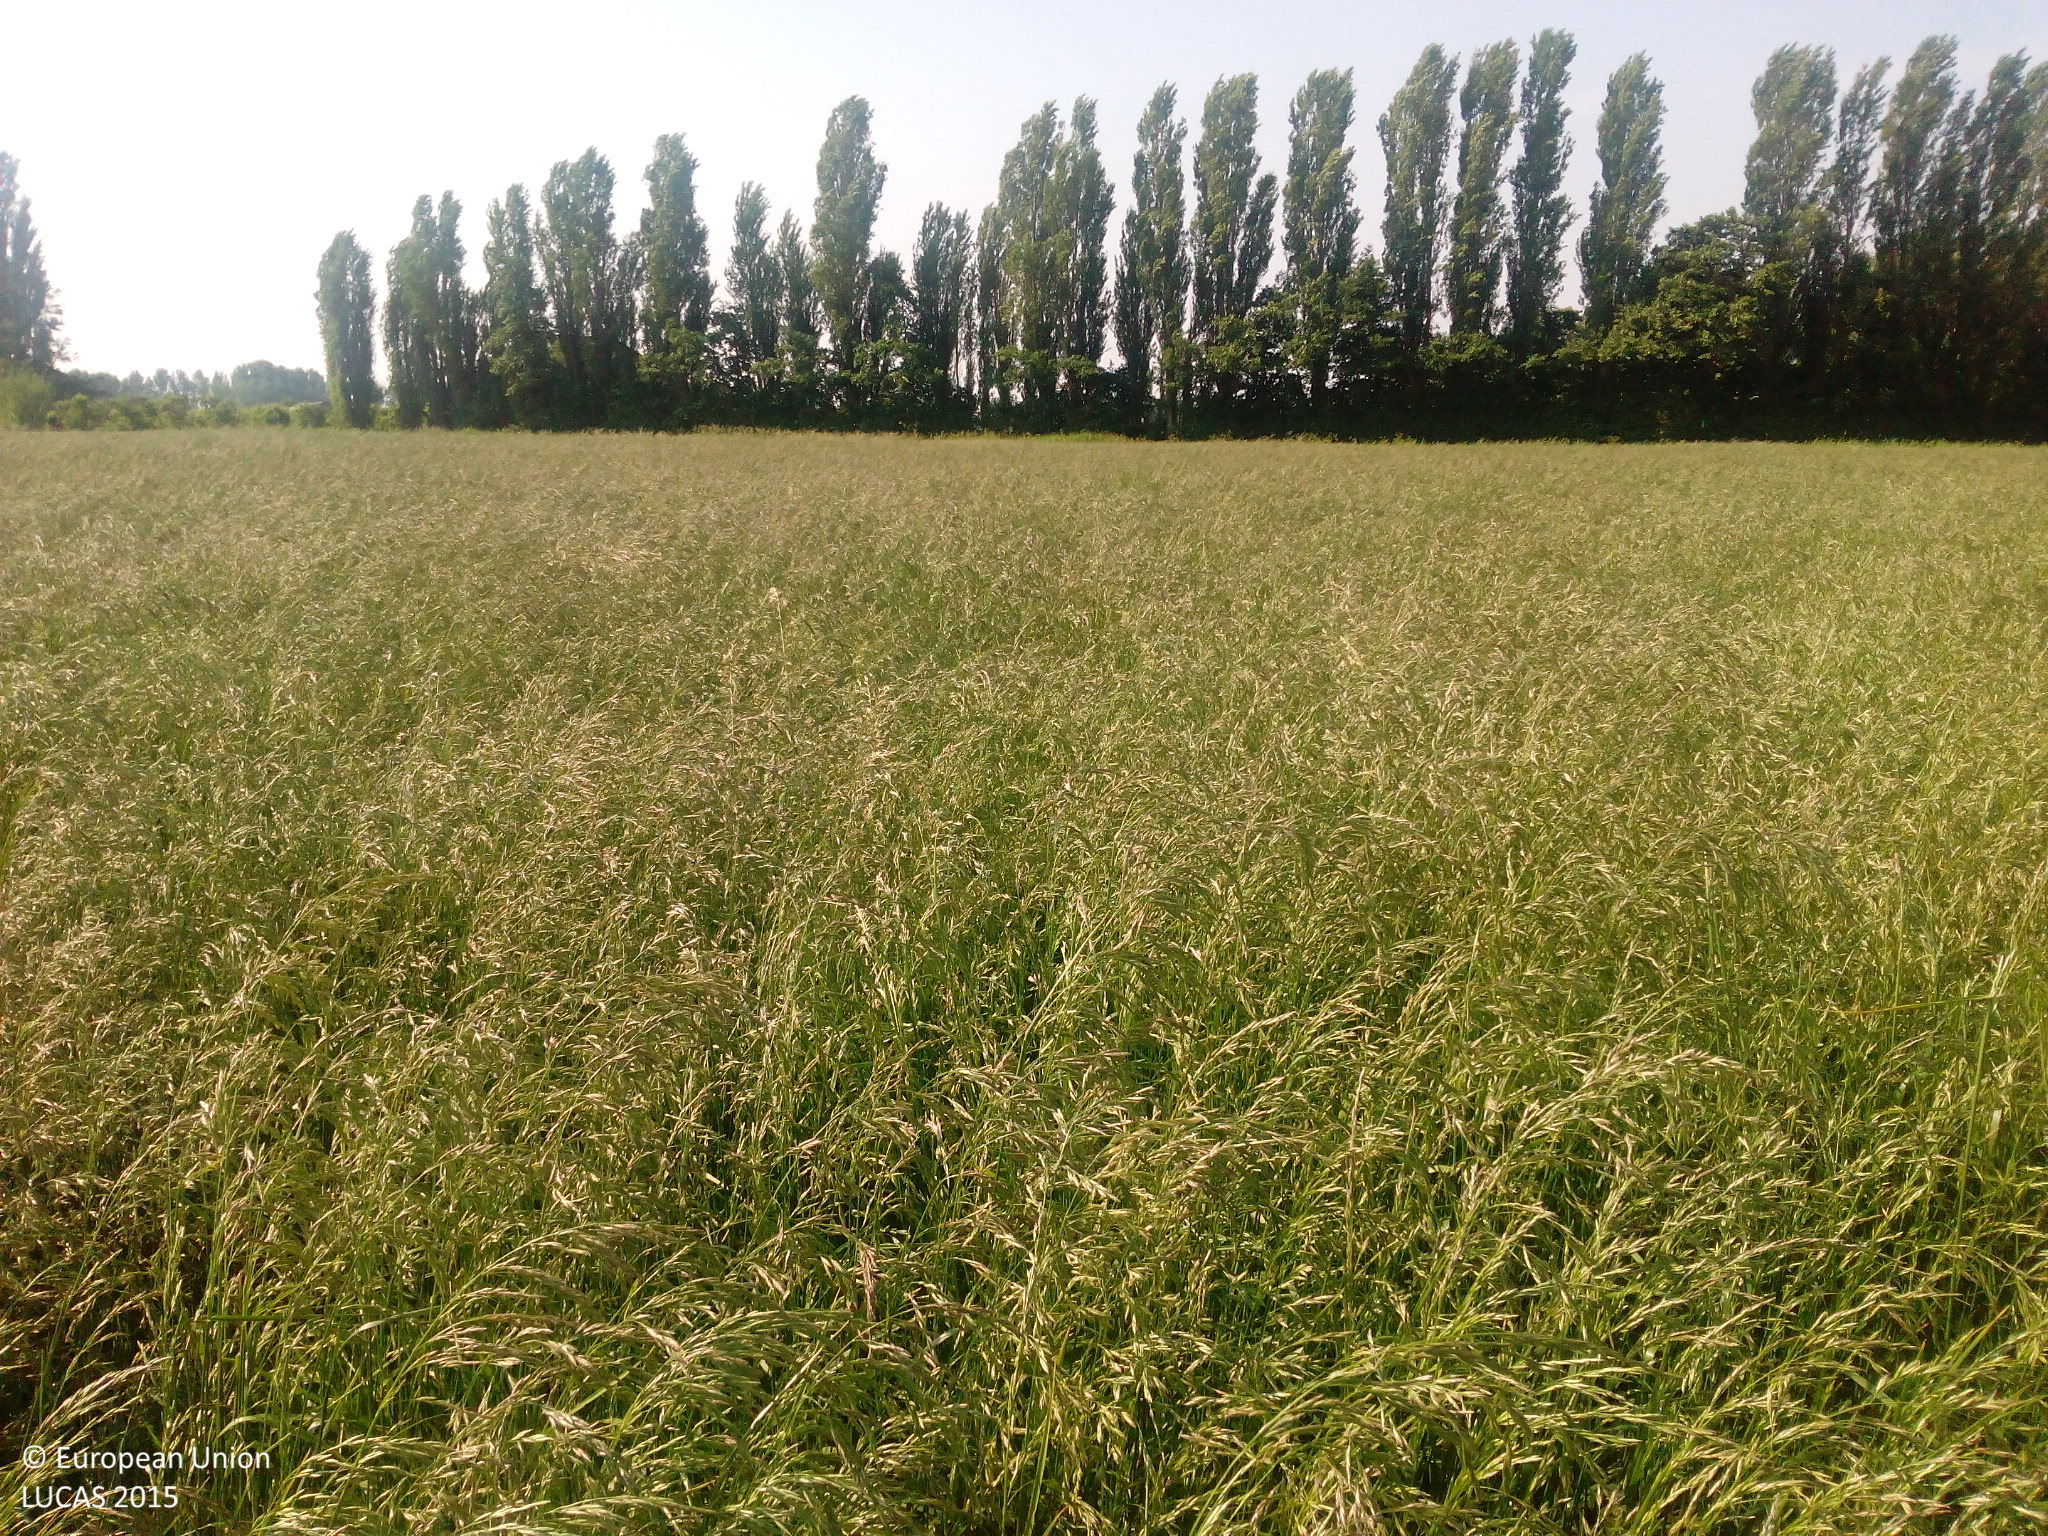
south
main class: Cropland
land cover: Temporary grasslands
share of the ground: > 75 %
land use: Agriculture (excluding fallow land and kitchen gardens)
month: June
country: NL
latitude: 51.5679
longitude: 4.1807
